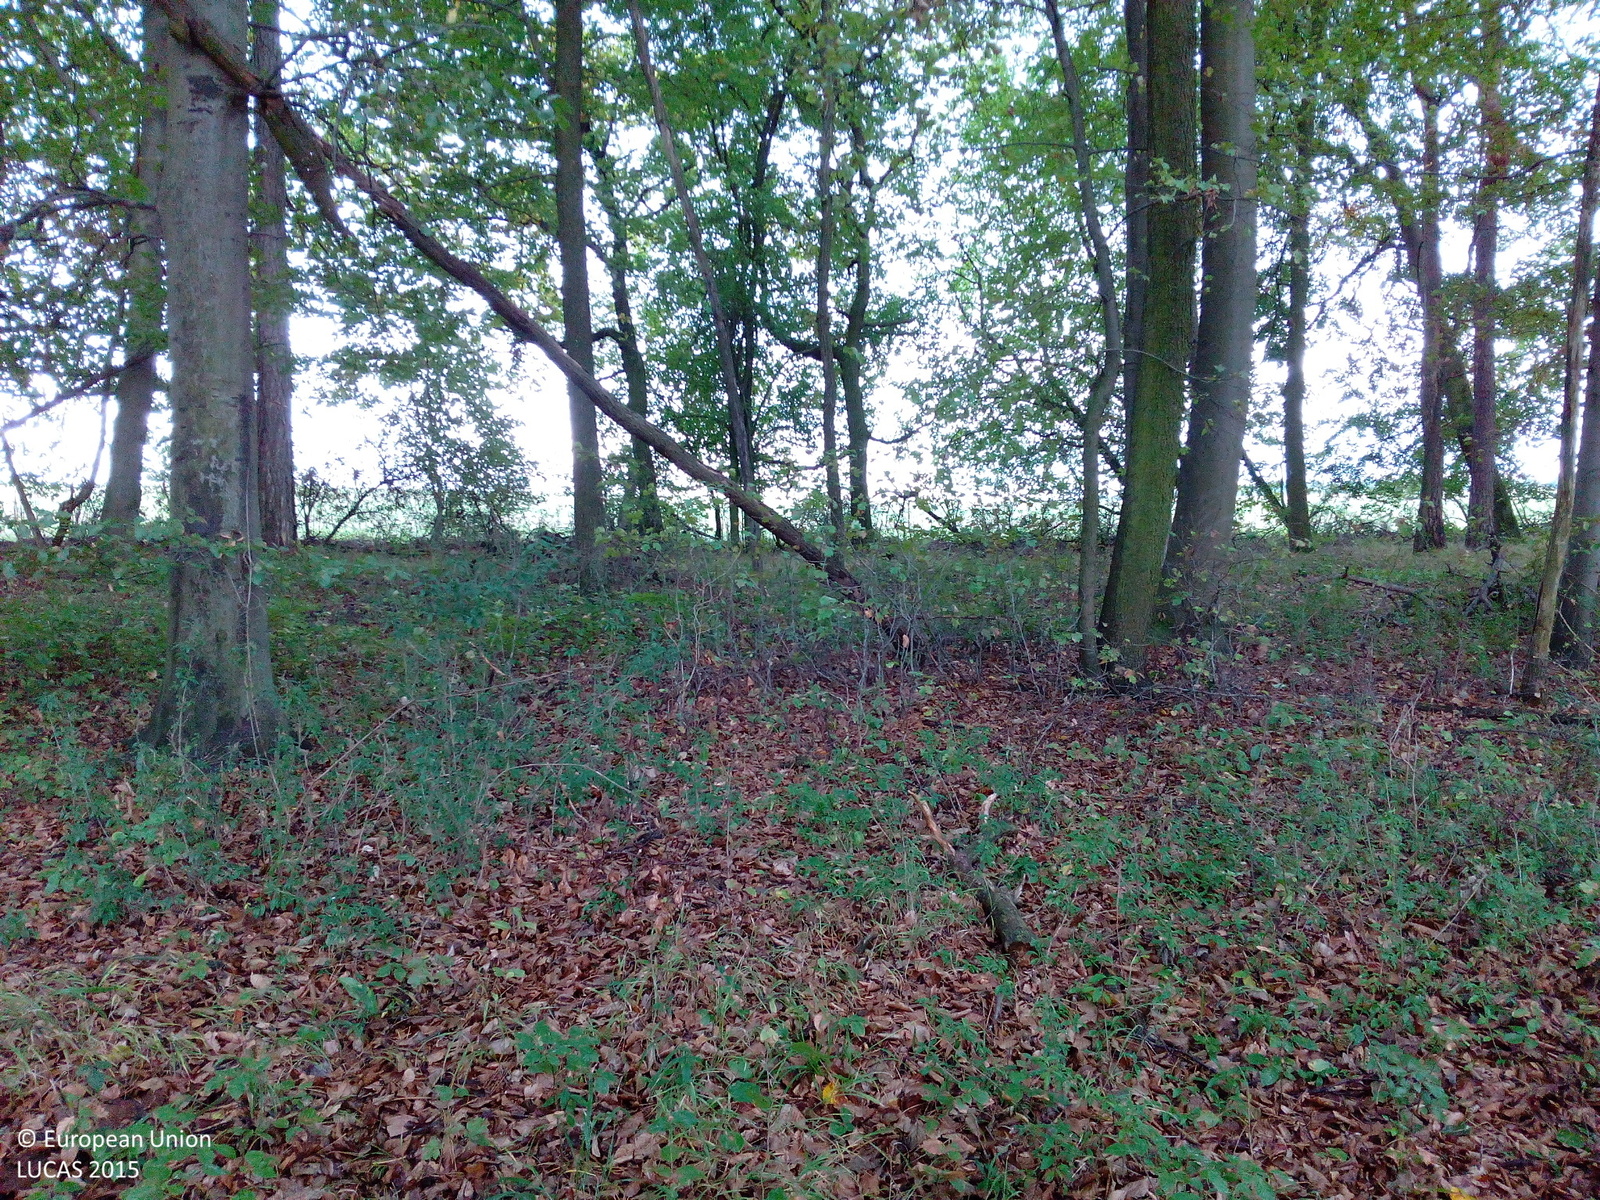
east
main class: Woodland
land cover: Pine dominated mixed woodland
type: hemiboreal forest and nemoral coniferous forest and mixed broadleaved-coniferous forest
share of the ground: > 75 %
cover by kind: broadleaved forest trees 45 %, coniferous forest trees 35 %, herbaceous plants 10 %, unconsolidated bare surface 10 %
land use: Forestry
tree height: > 5 m
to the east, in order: Pine dominated mixed woodland; Grass margins; Rye; Tracks; Rye
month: September
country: DE
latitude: 49.9324
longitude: 9.9025
